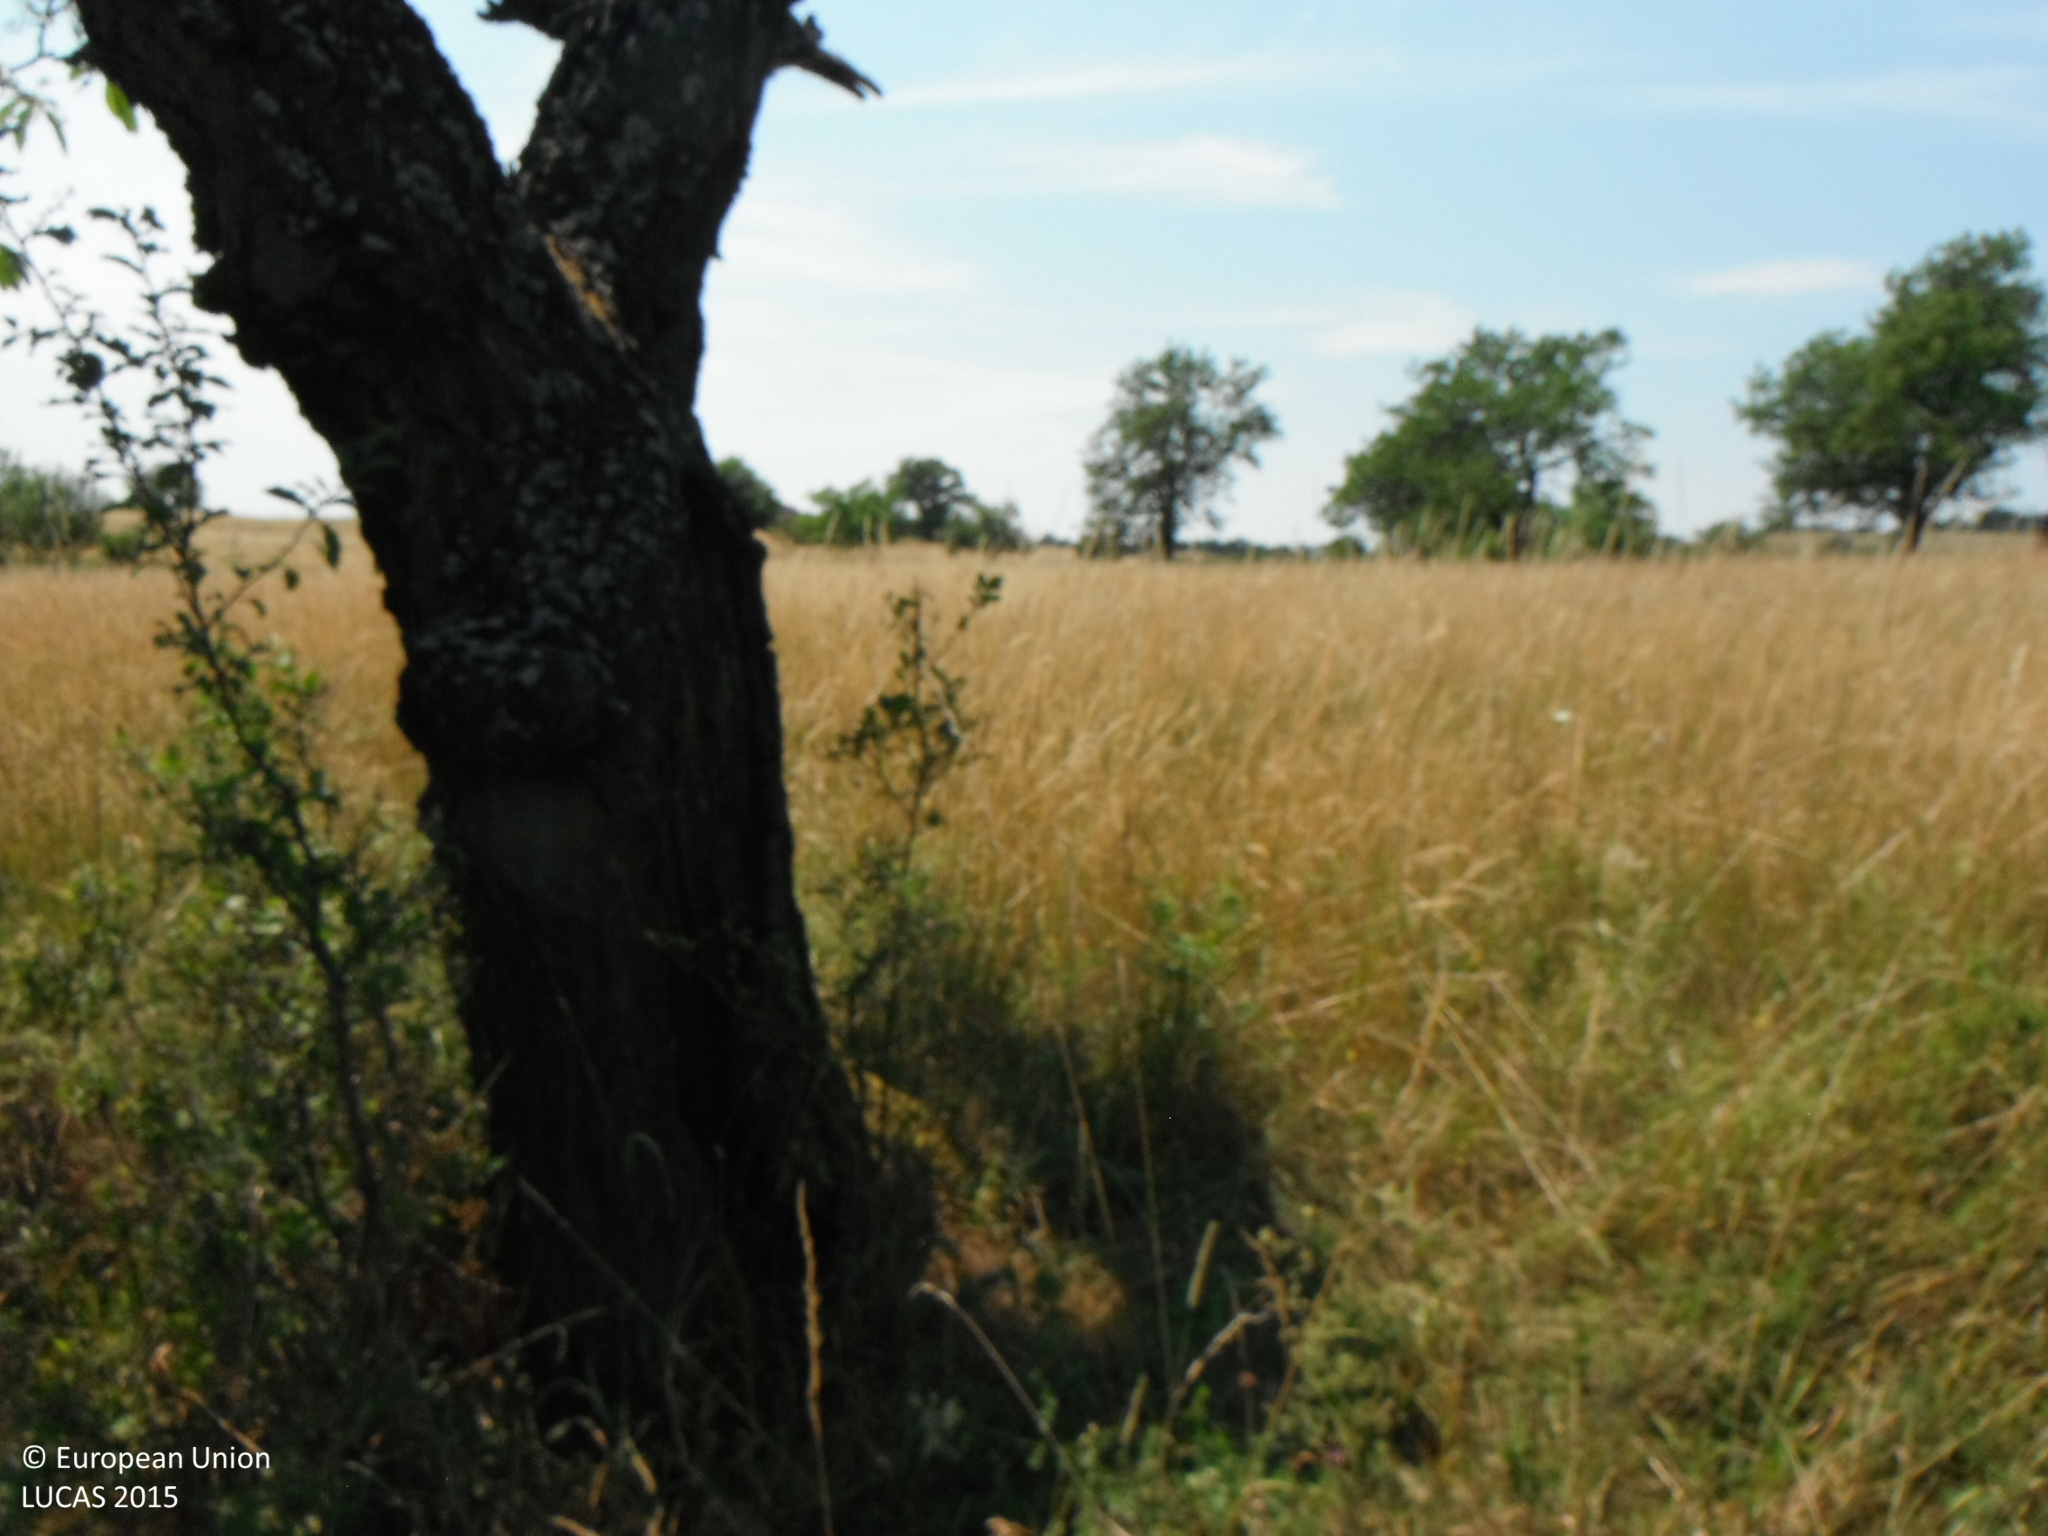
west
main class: Cropland
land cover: Cherry fruit
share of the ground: 10 - 25 %
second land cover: Grassland without tree/shrub cover
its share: > 75 %
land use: Agriculture (excluding fallow land and kitchen gardens)
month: July
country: SK
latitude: 48.1905
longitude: 19.1007
